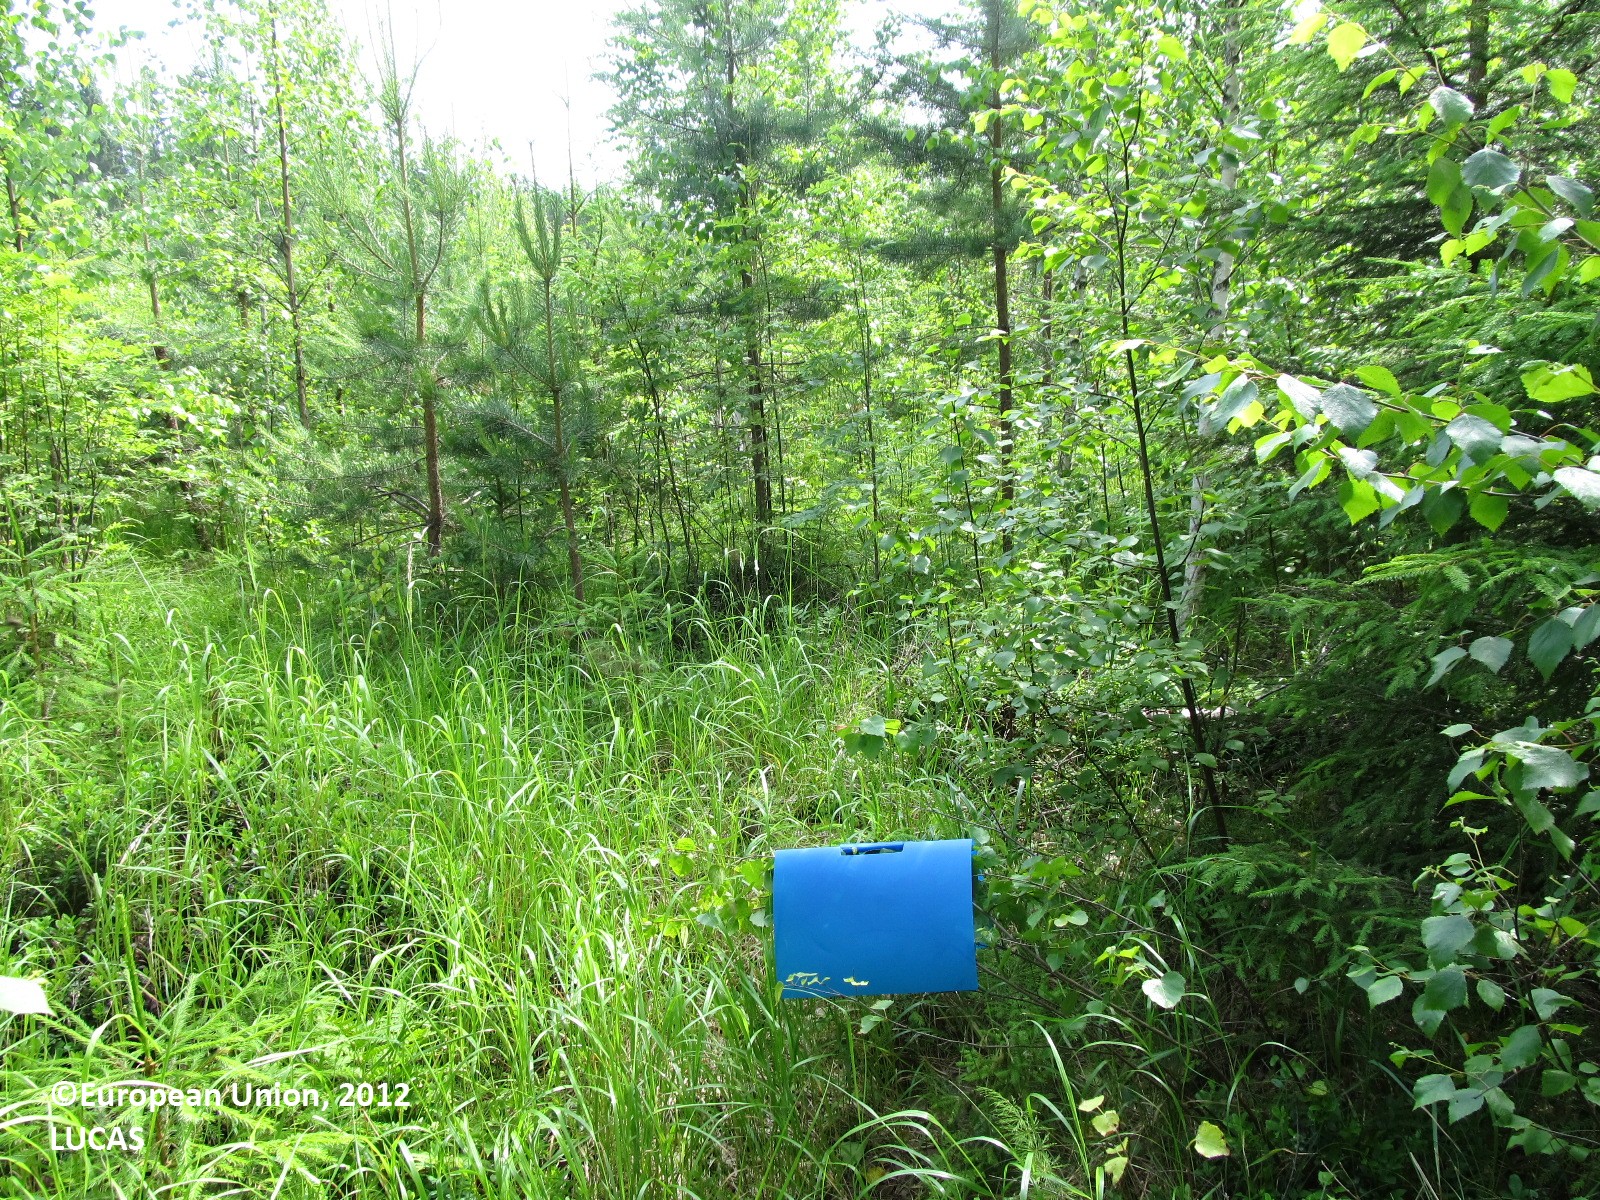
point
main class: Woodland
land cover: Pine dominated mixed woodland
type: boreal forest
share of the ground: 25 - 50 %
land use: Forestry
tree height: < 5 m
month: July
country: FI
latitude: 61.9286
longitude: 29.1081
